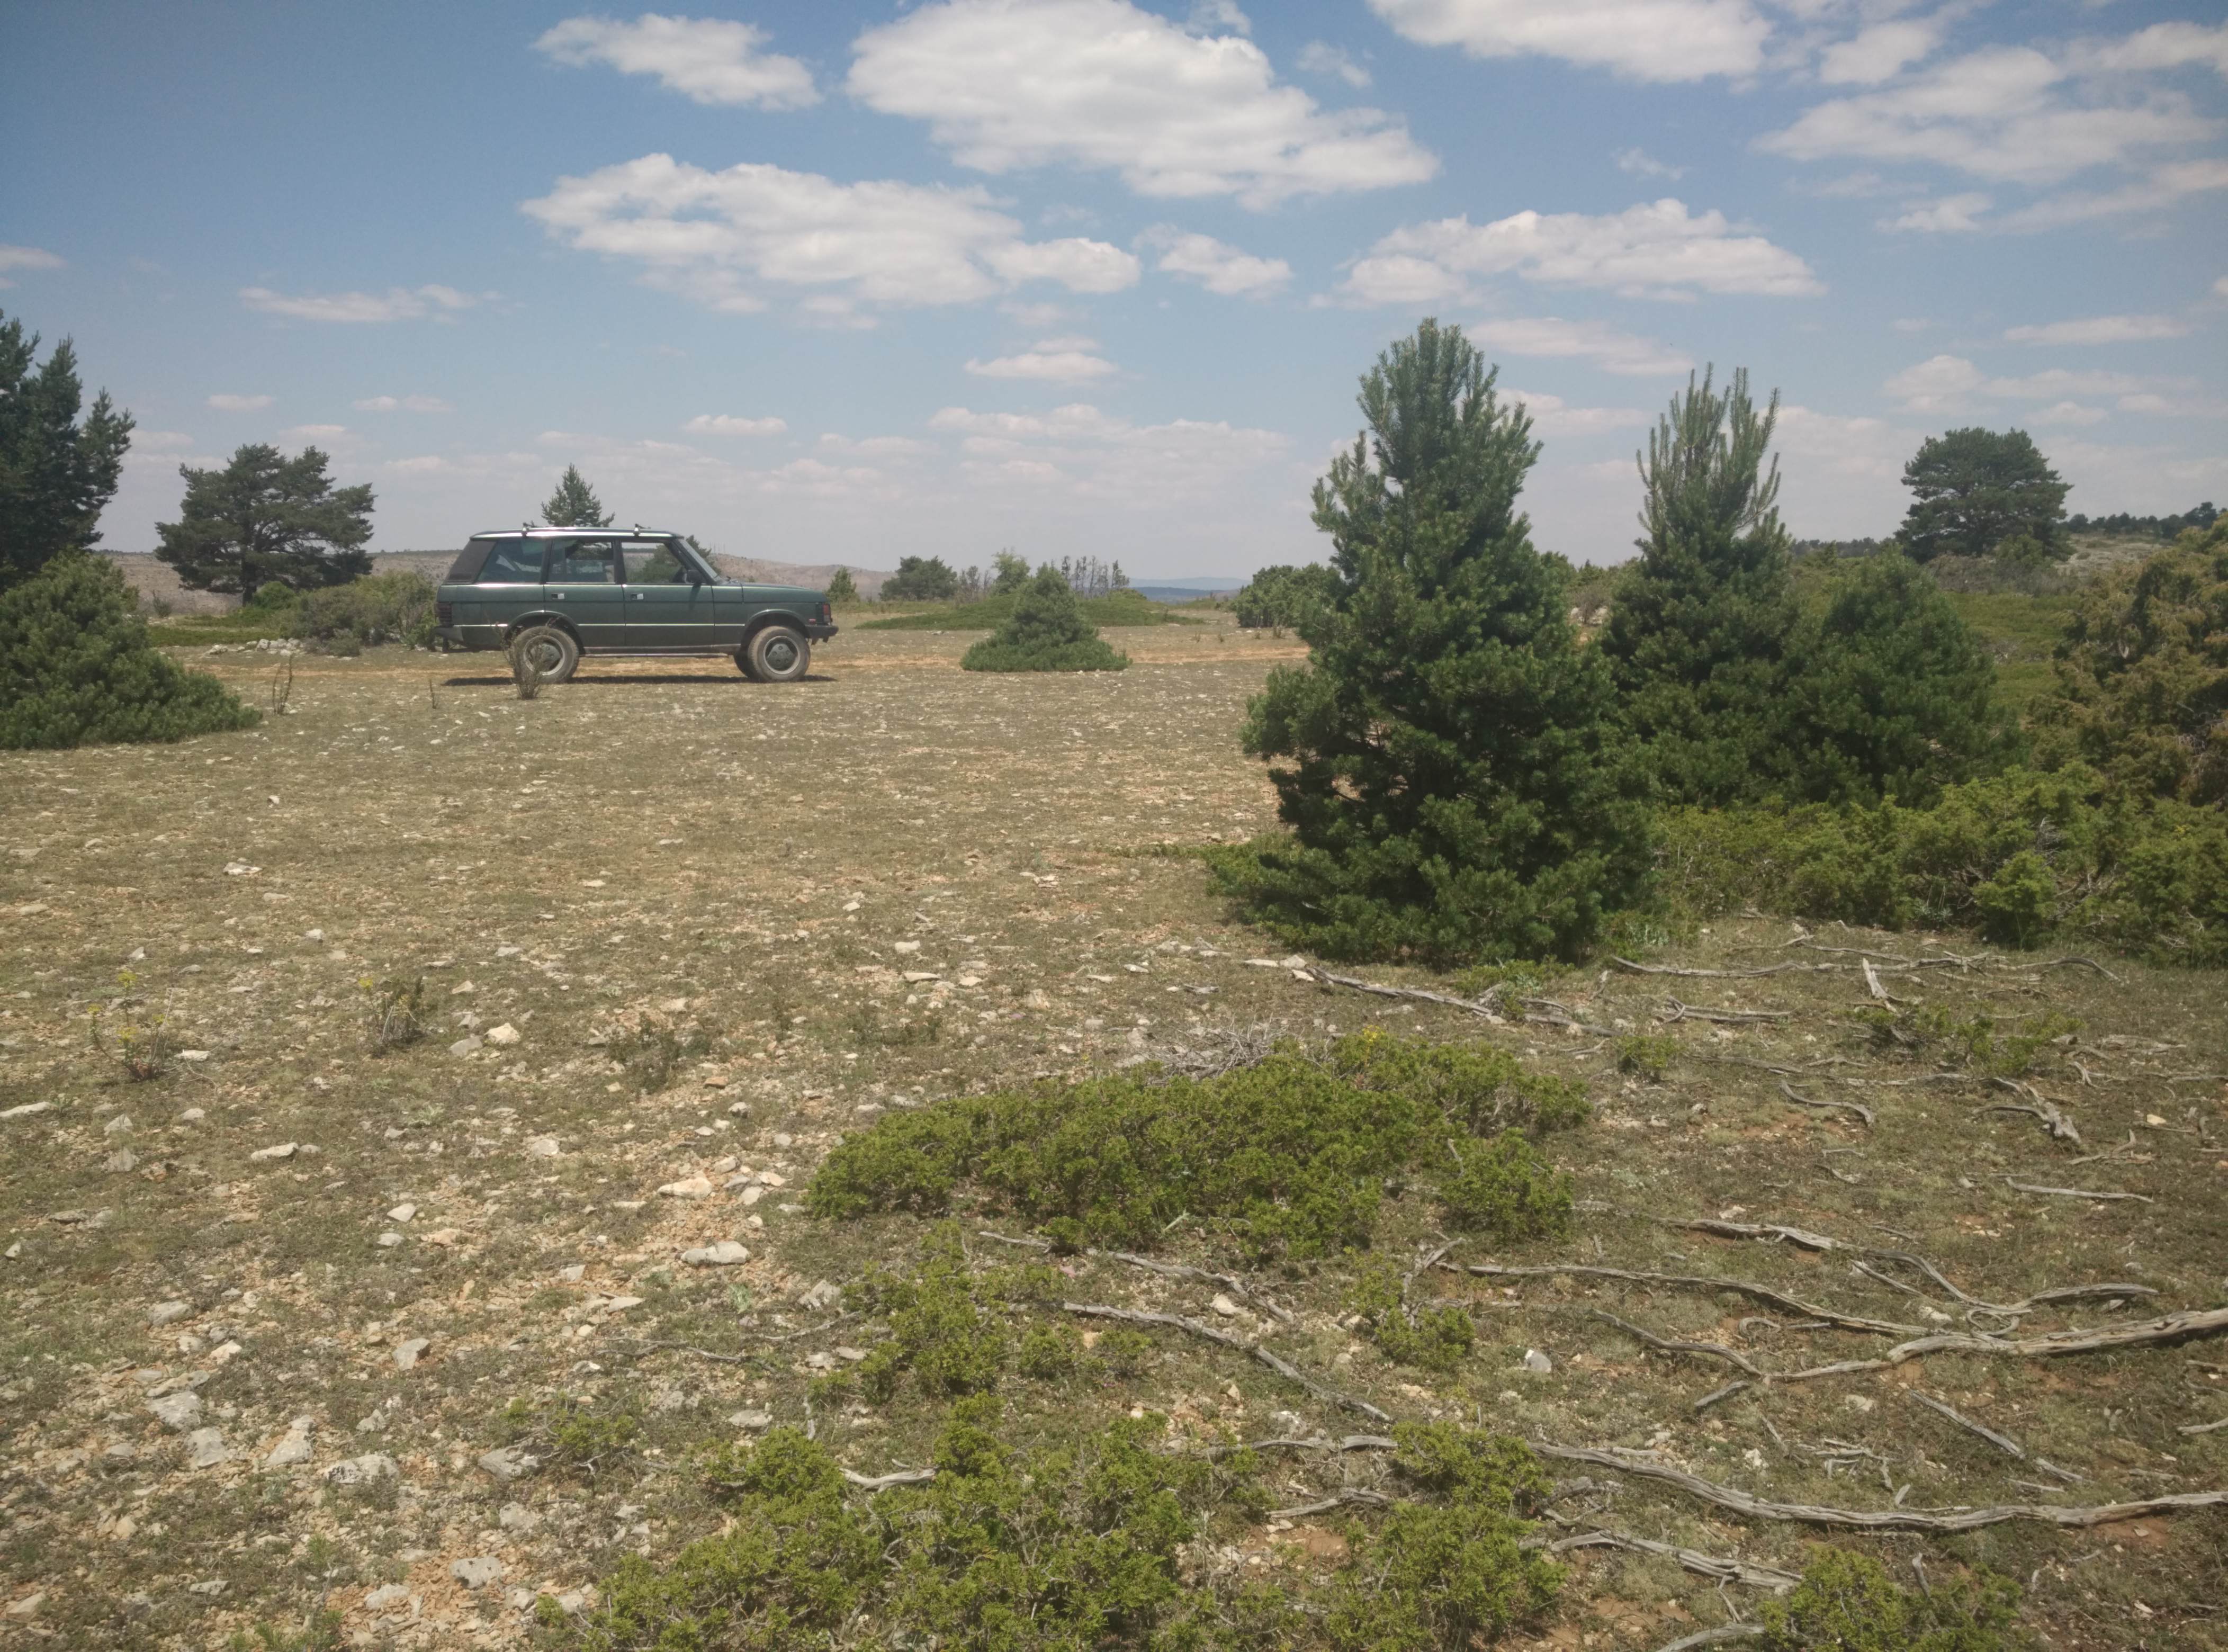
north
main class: Shrubland
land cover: Shrubland with sparse tree cover
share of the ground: 25 - 50 %
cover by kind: unconsolidated bare surface 60 %, shrubs 25 %, herbaceous plants 10 %, coniferous forest trees 5 %
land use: Semi-natural and natural areas not in use
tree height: > 5 m
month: June
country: ES
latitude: 40.5578
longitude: -1.7927
